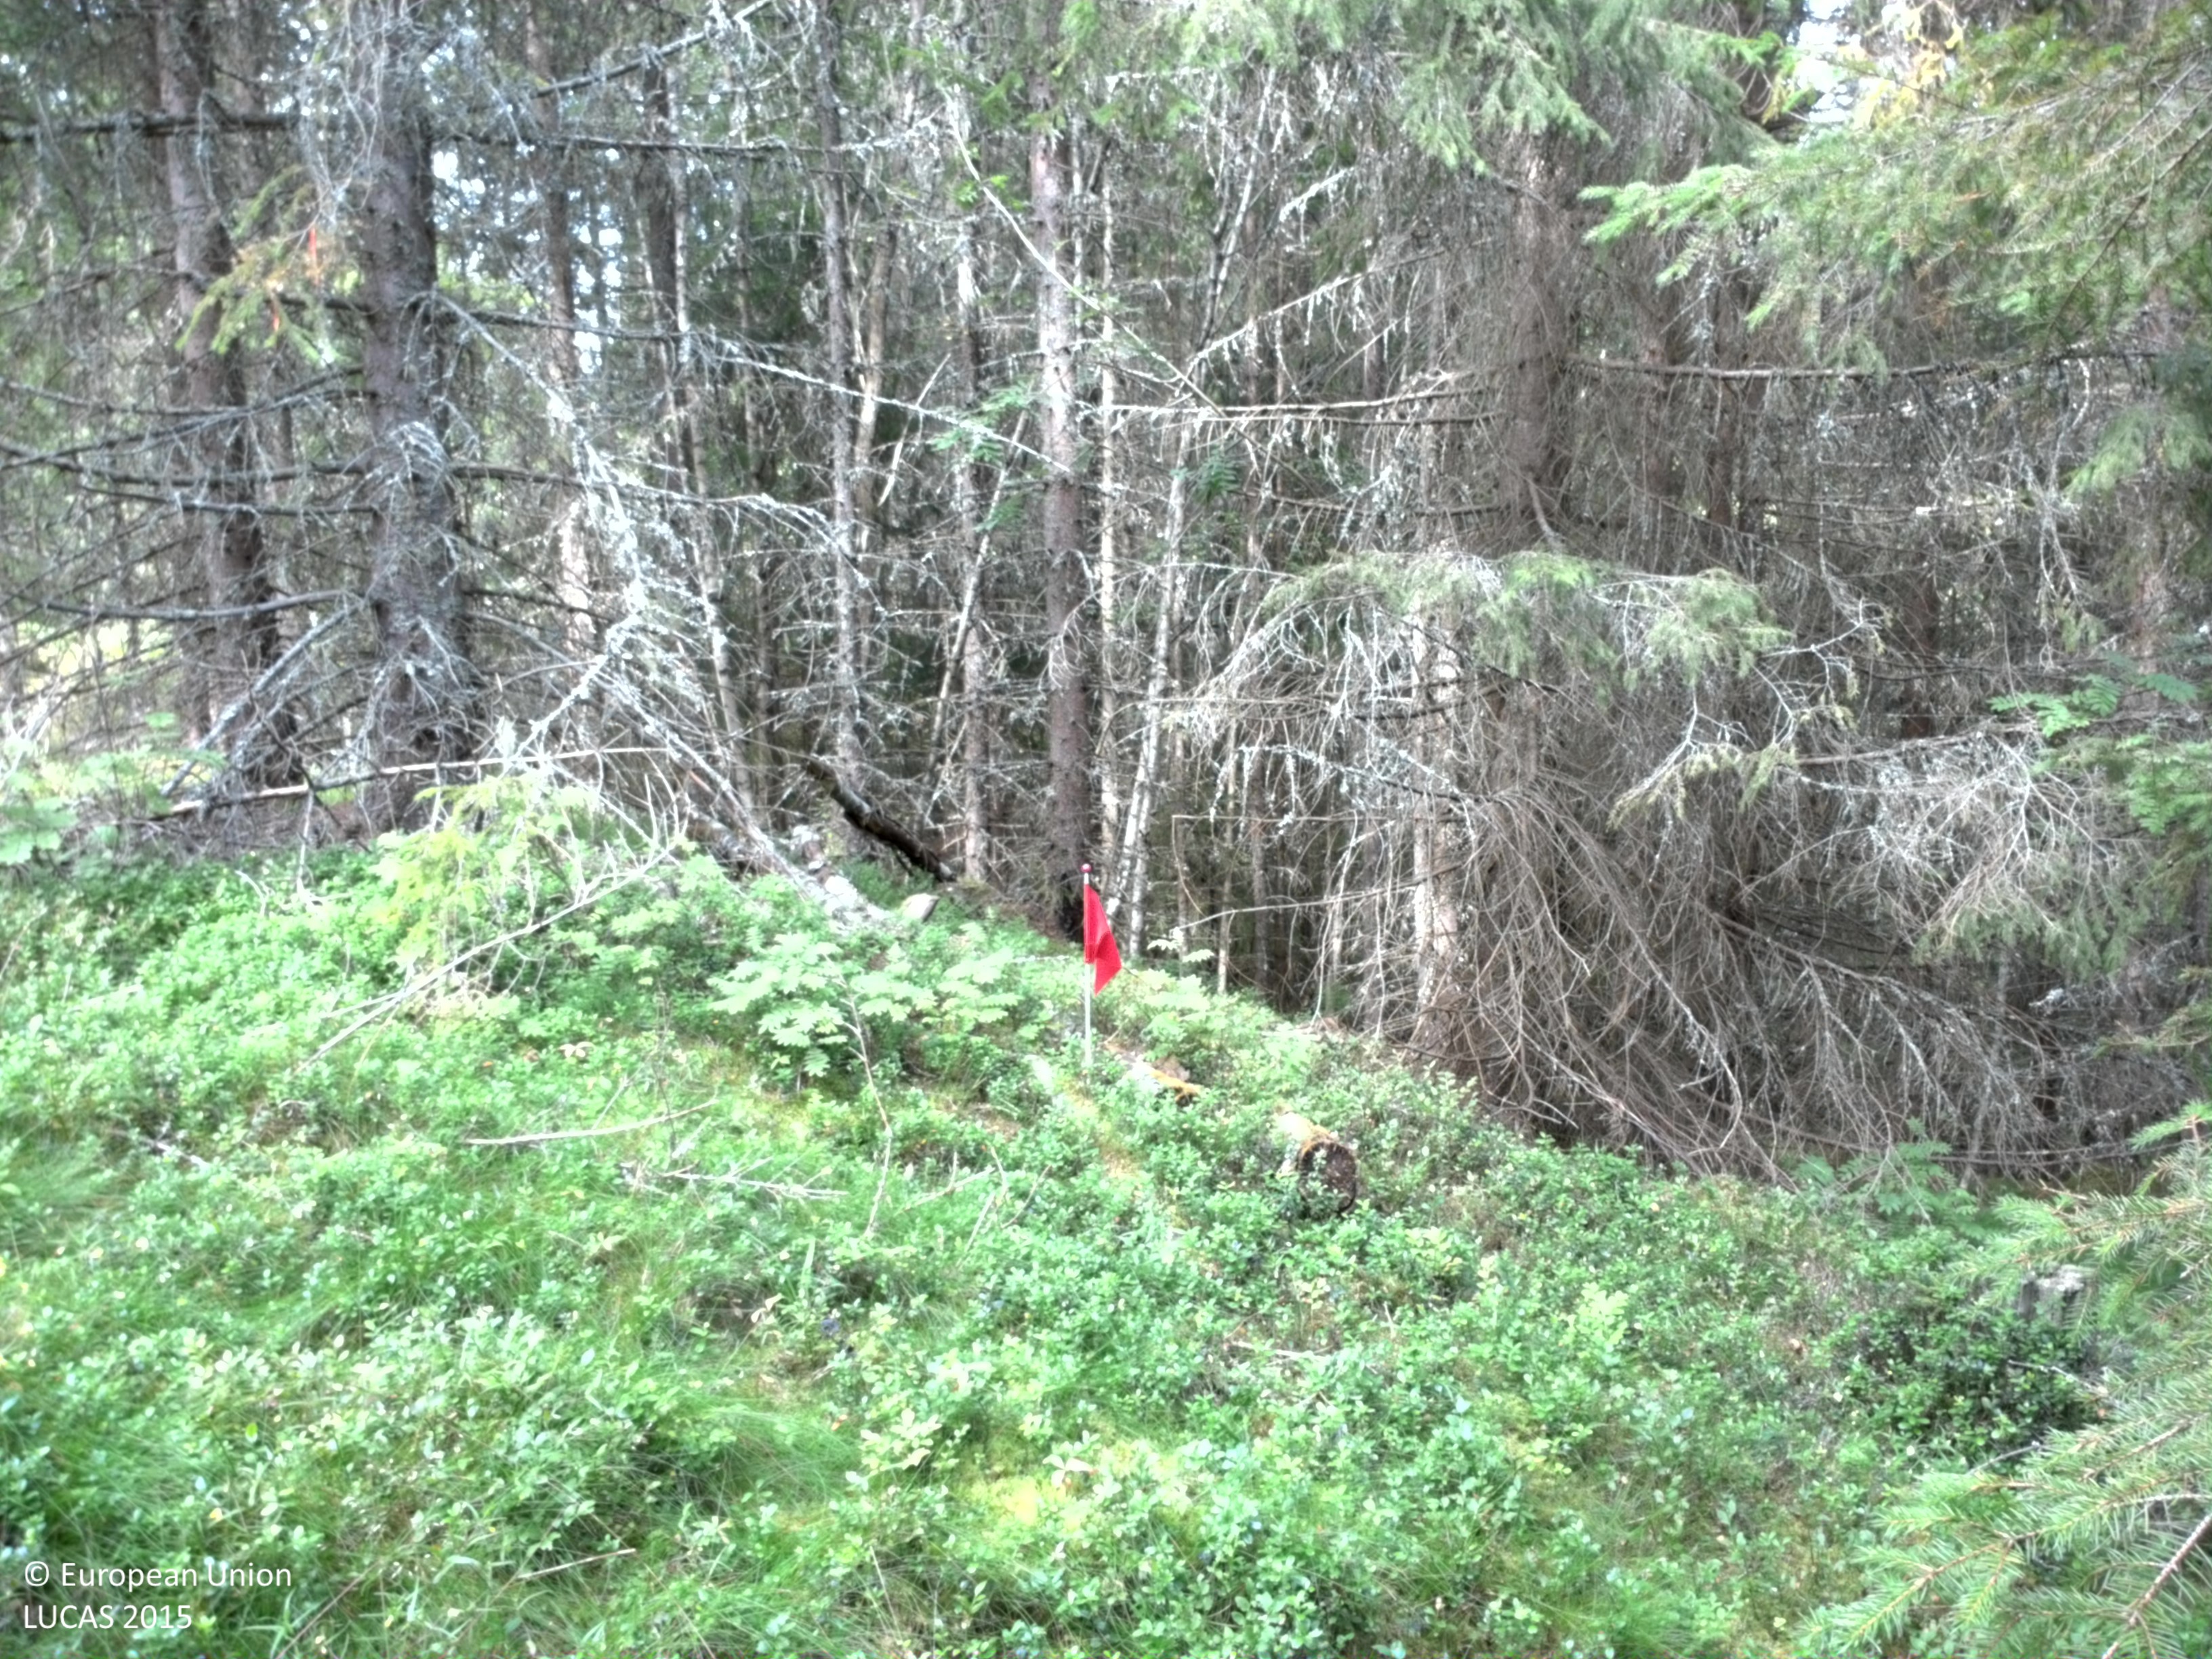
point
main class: Woodland
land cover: Spruce dominated coniferous woodland
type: boreal forest
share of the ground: 50 - 75 %
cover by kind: coniferous forest trees 60 %, shrubs 20 %, lichens and mosses 10 %, broadleaved forest trees 5 %, herbaceous plants 5 %
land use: Forestry
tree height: > 5 m
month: August
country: SE
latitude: 60.0285
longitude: 13.5260
